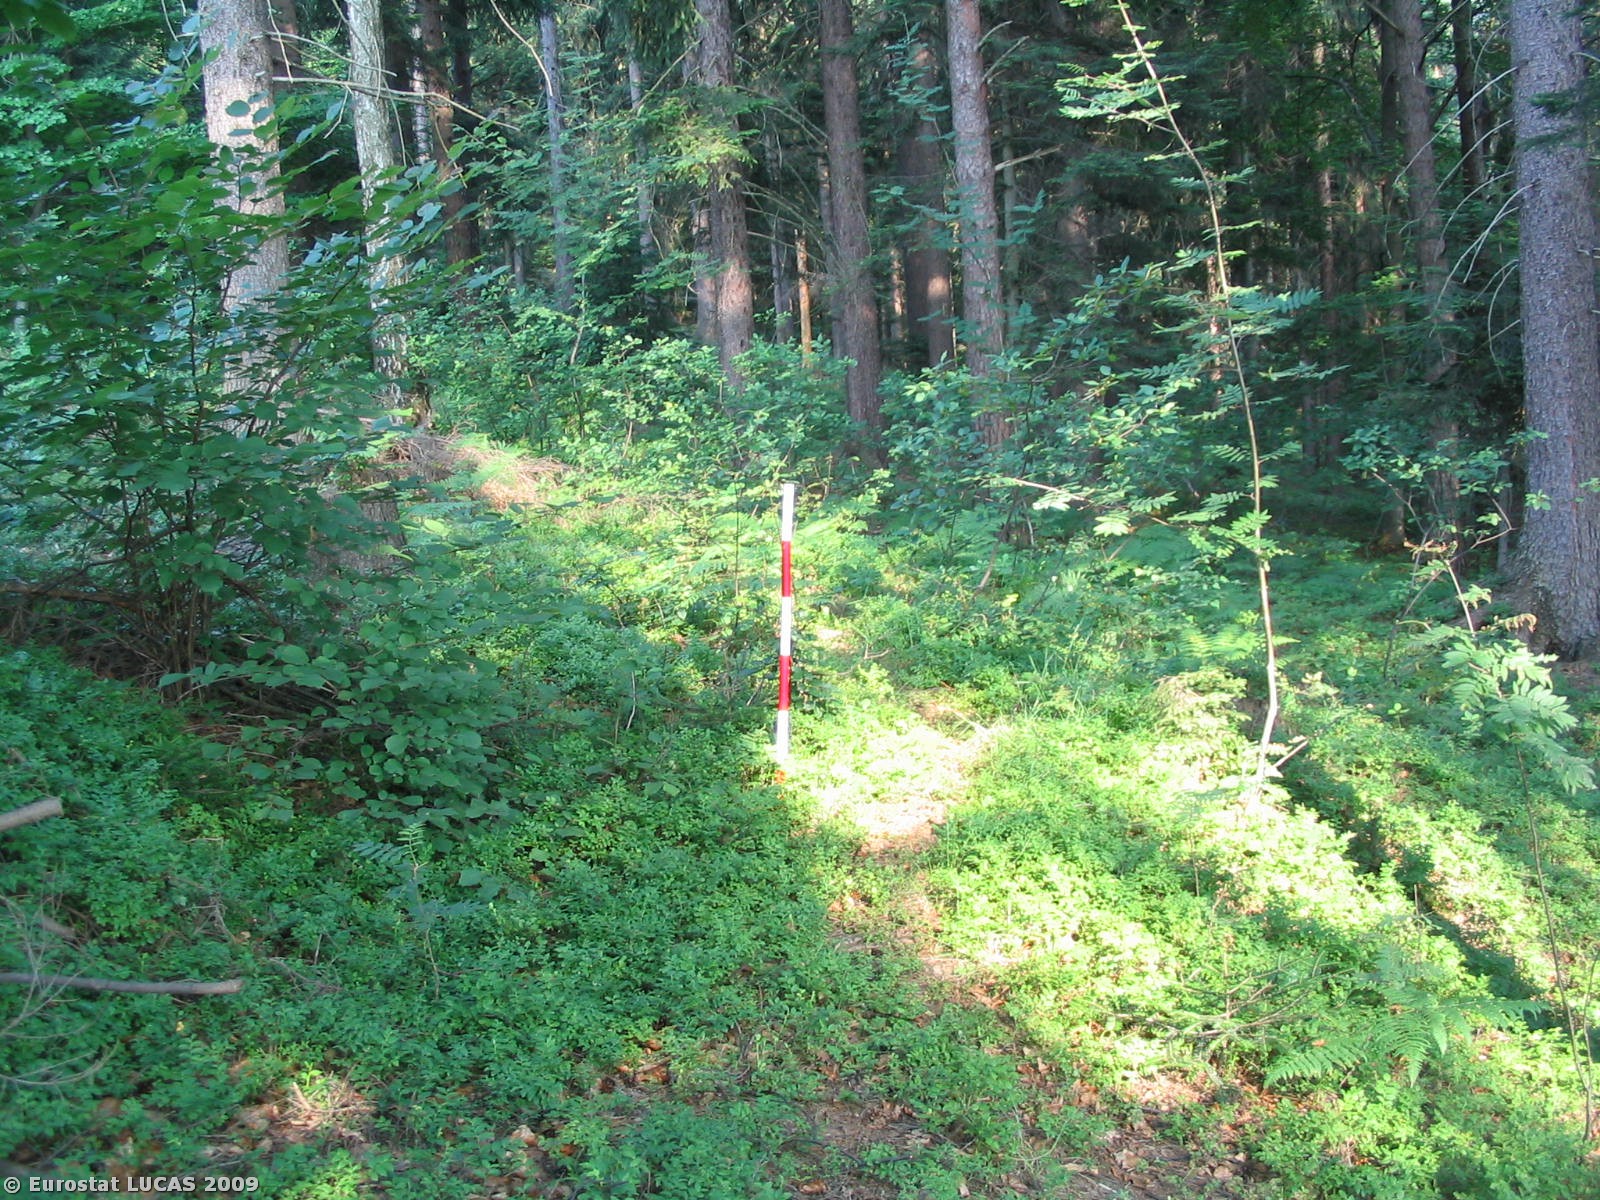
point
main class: Woodland
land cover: Mixed woodland
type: hemiboreal forest and nemoral coniferous forest and mixed broadleaved-coniferous forest
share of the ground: > 75 %
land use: Forestry
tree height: > 5 m
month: July
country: CZ
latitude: 49.6119
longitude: 18.7533
